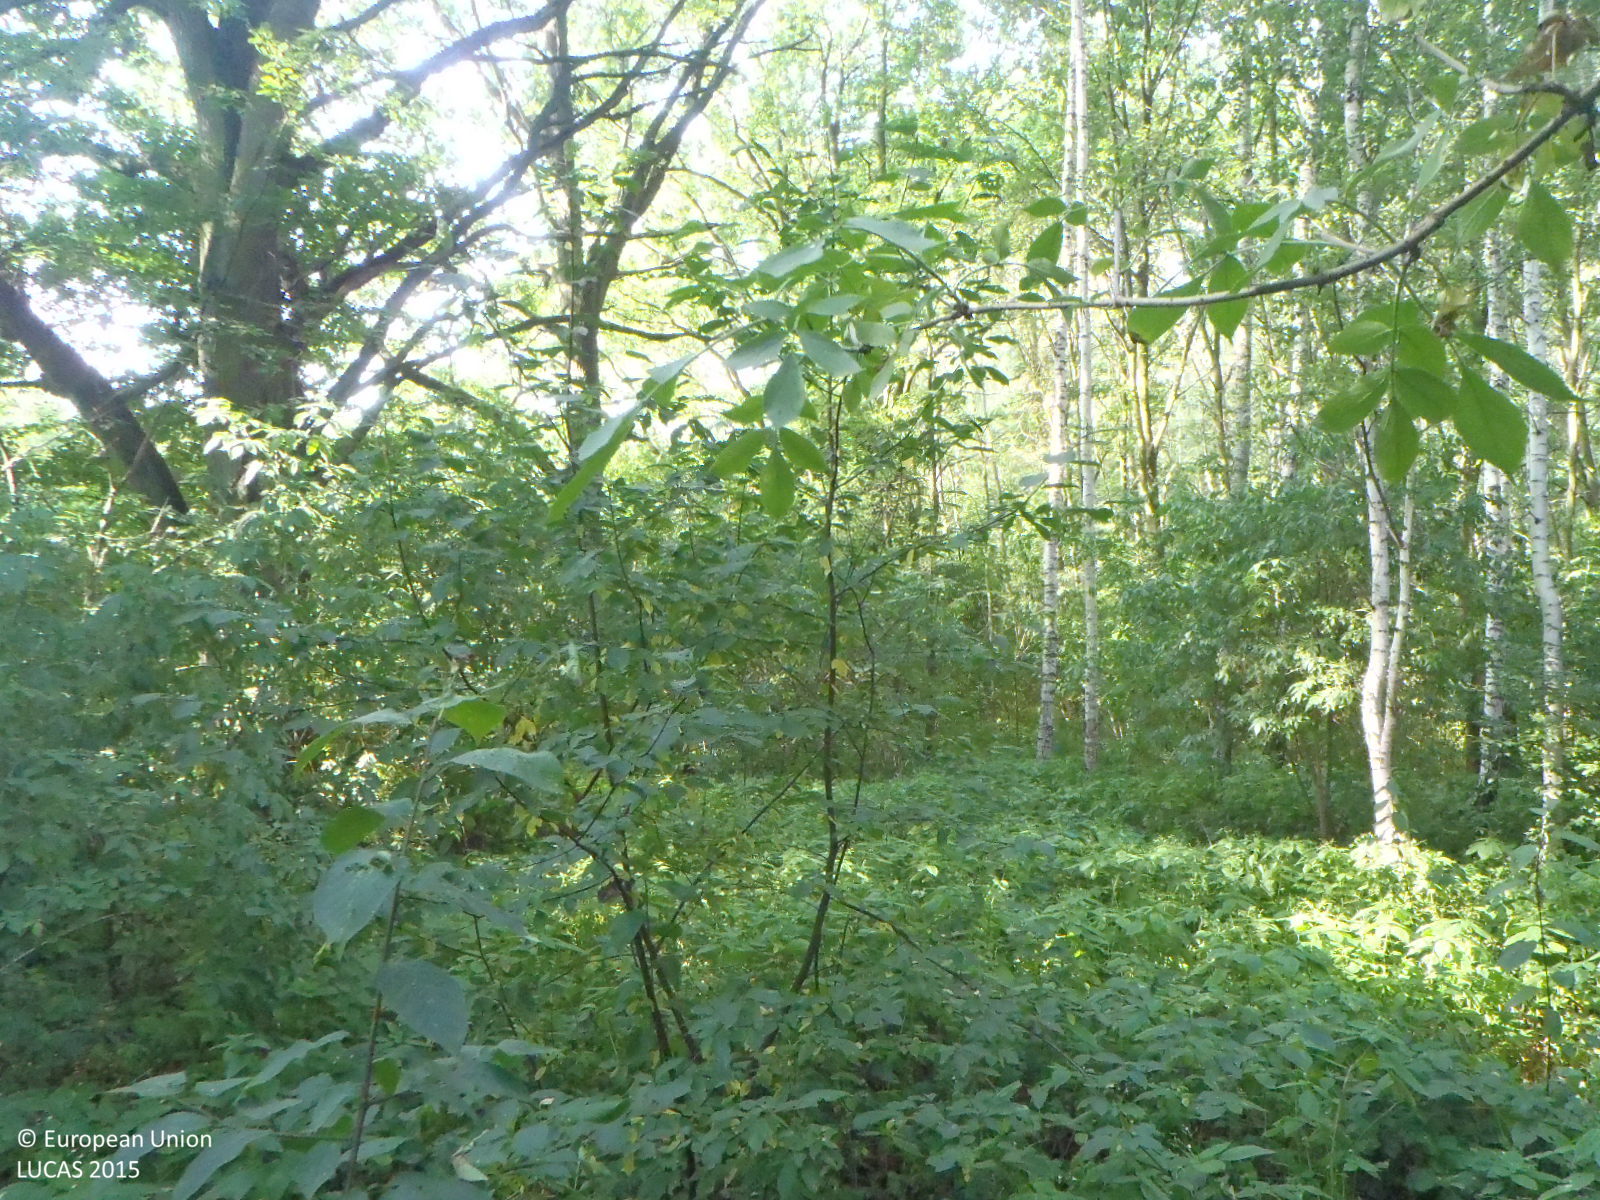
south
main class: Woodland
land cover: Broadleaved woodland
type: mesophytic deciduous forest
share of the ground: > 75 %
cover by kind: broadleaved forest trees 95 %, herbaceous plants 5 %
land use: Forestry
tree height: > 5 m
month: August
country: CZ
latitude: 50.7070
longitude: 14.5191
